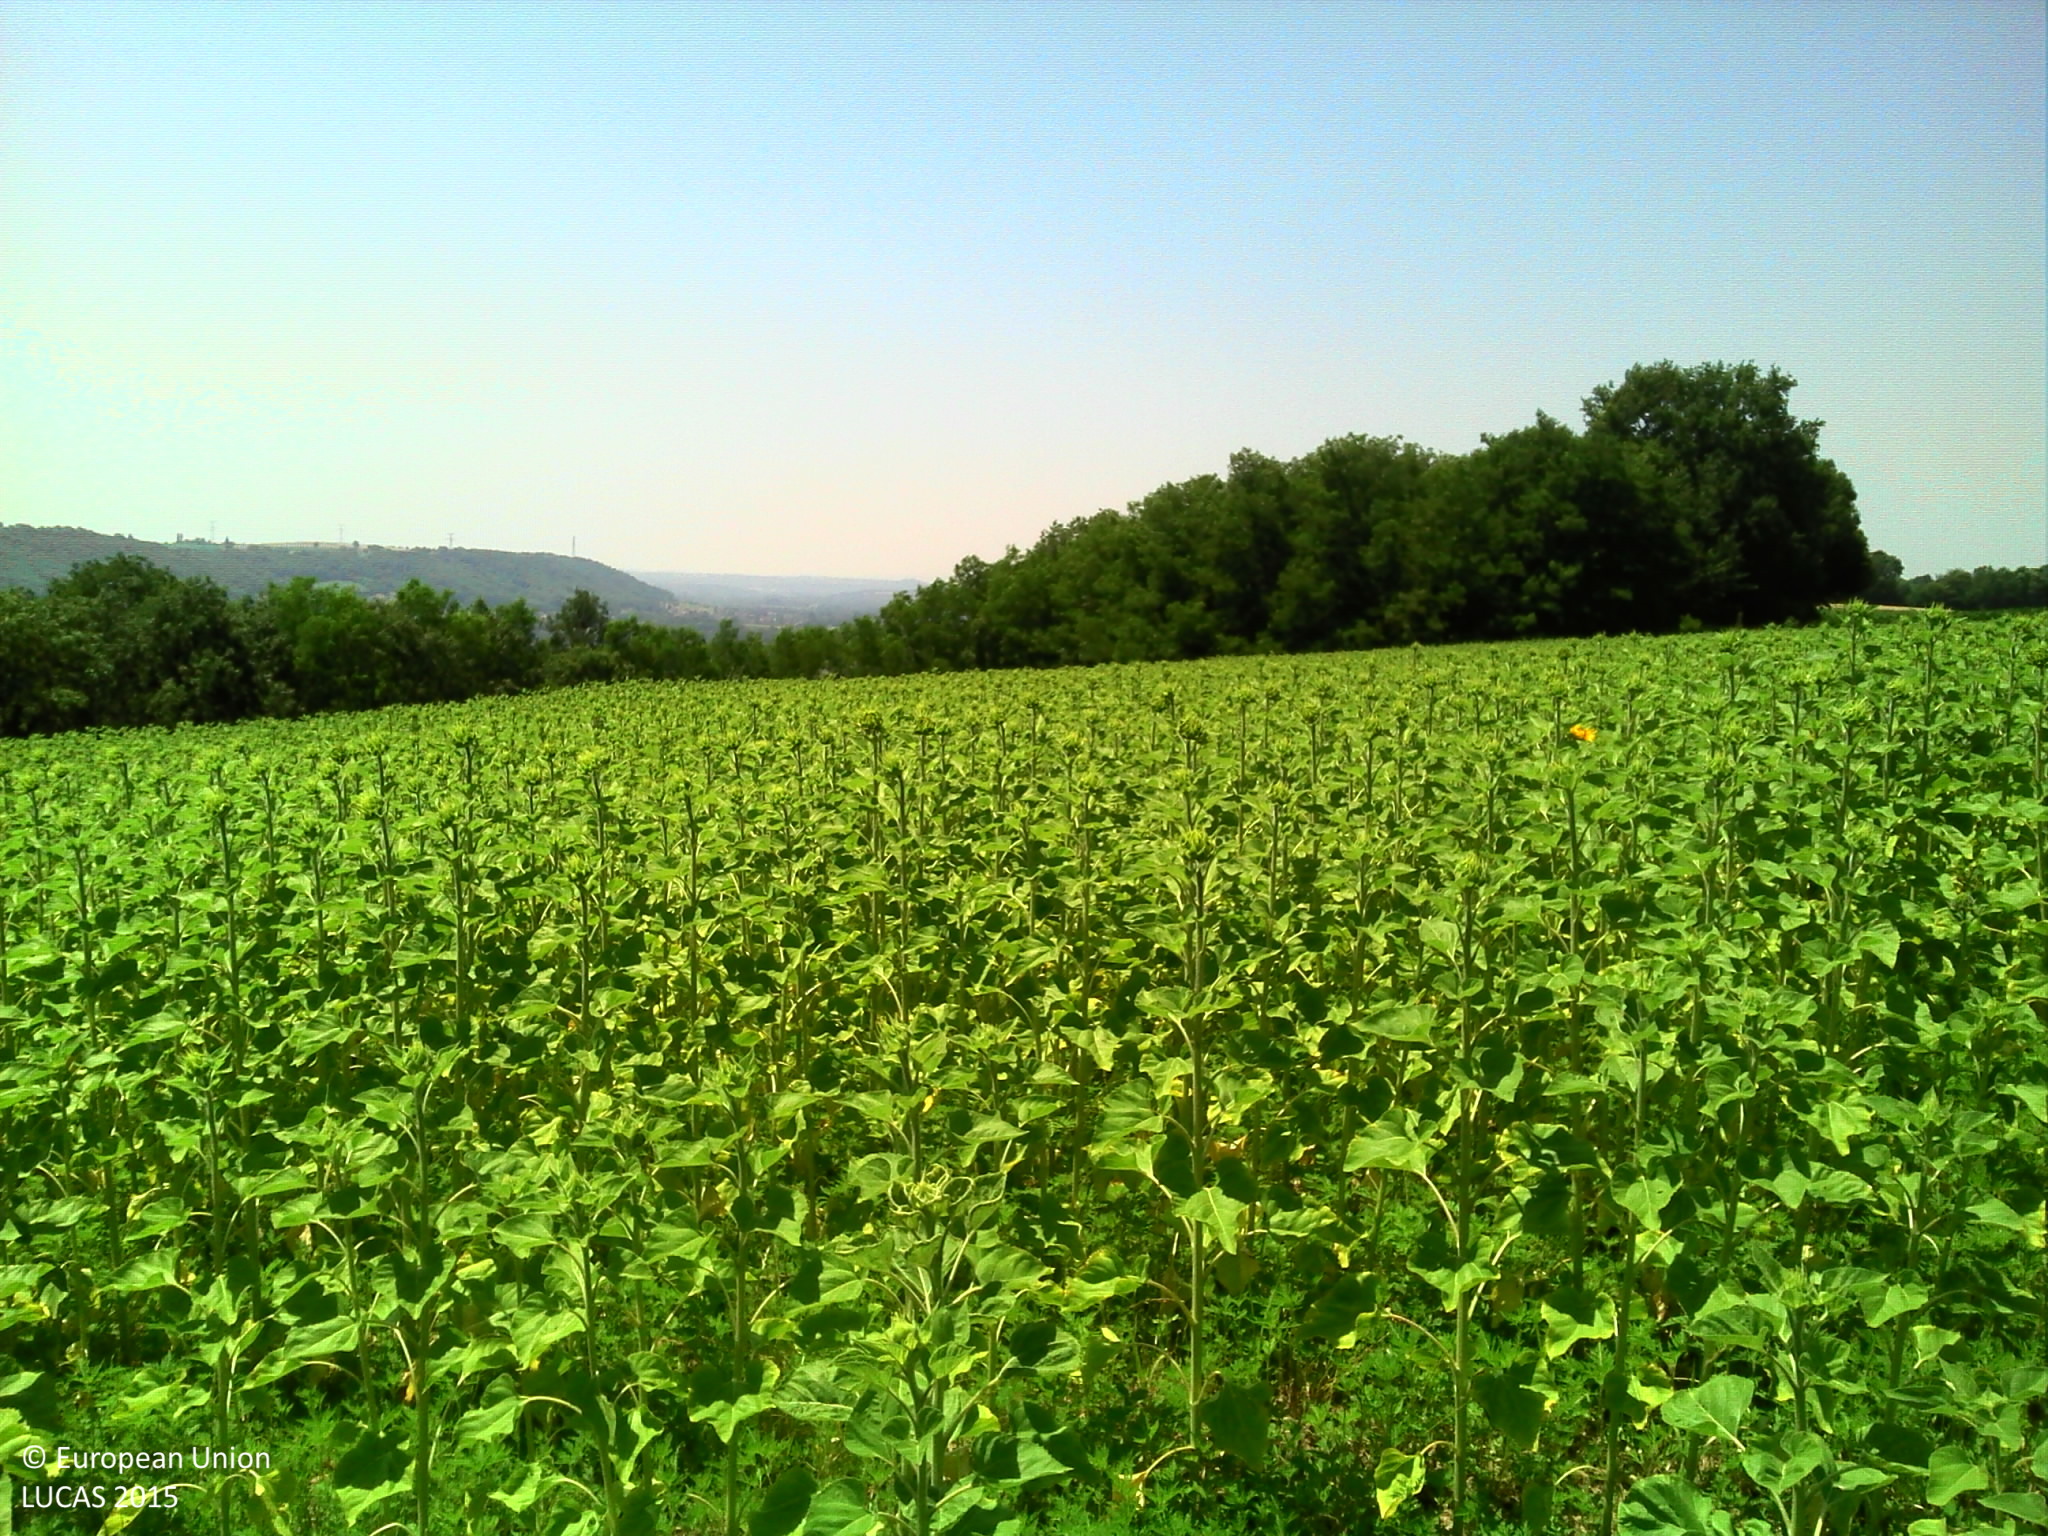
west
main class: Cropland
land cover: Durum wheat
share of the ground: > 75 %
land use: Agriculture (excluding fallow land and kitchen gardens)
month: July
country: FR
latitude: 45.6556
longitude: 5.3715
